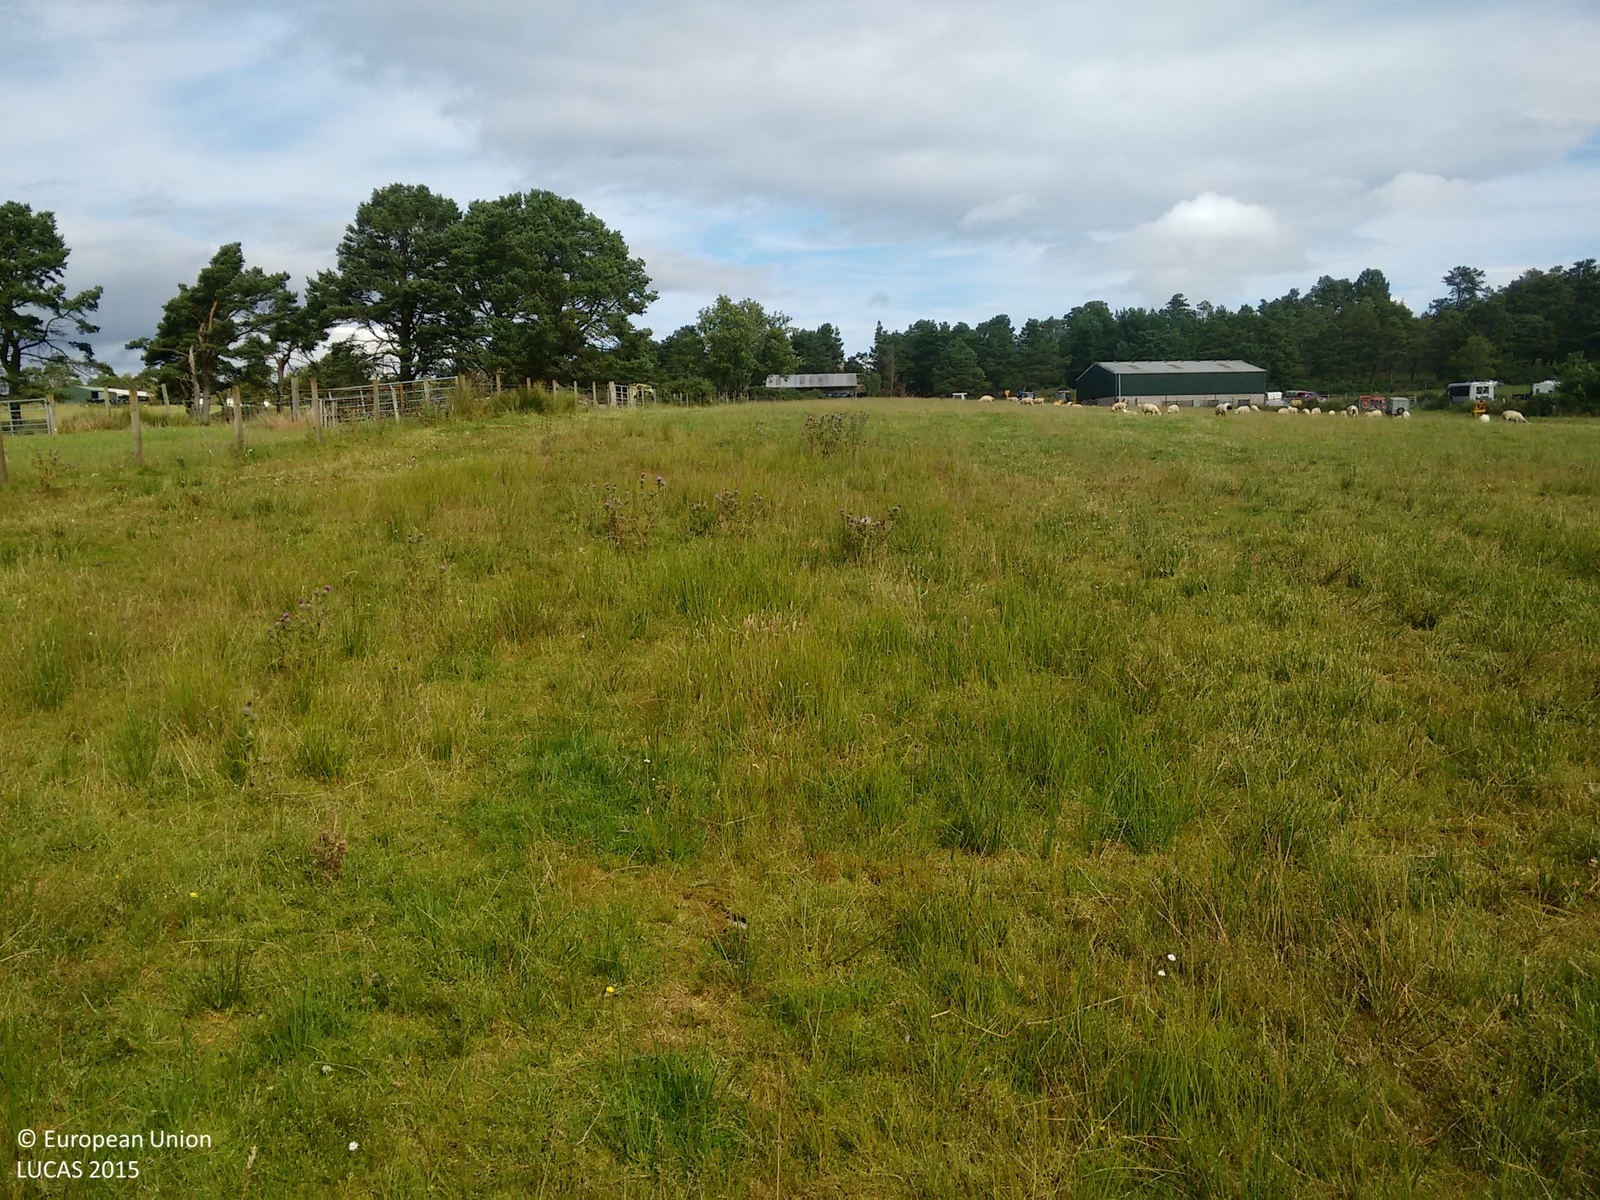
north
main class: Grassland
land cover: Grassland without tree/shrub cover
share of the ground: > 75 %
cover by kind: herbaceous plants 100 %
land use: Agriculture (excluding fallow land and kitchen gardens)
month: August
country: GB
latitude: 57.9097
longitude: -4.1048
